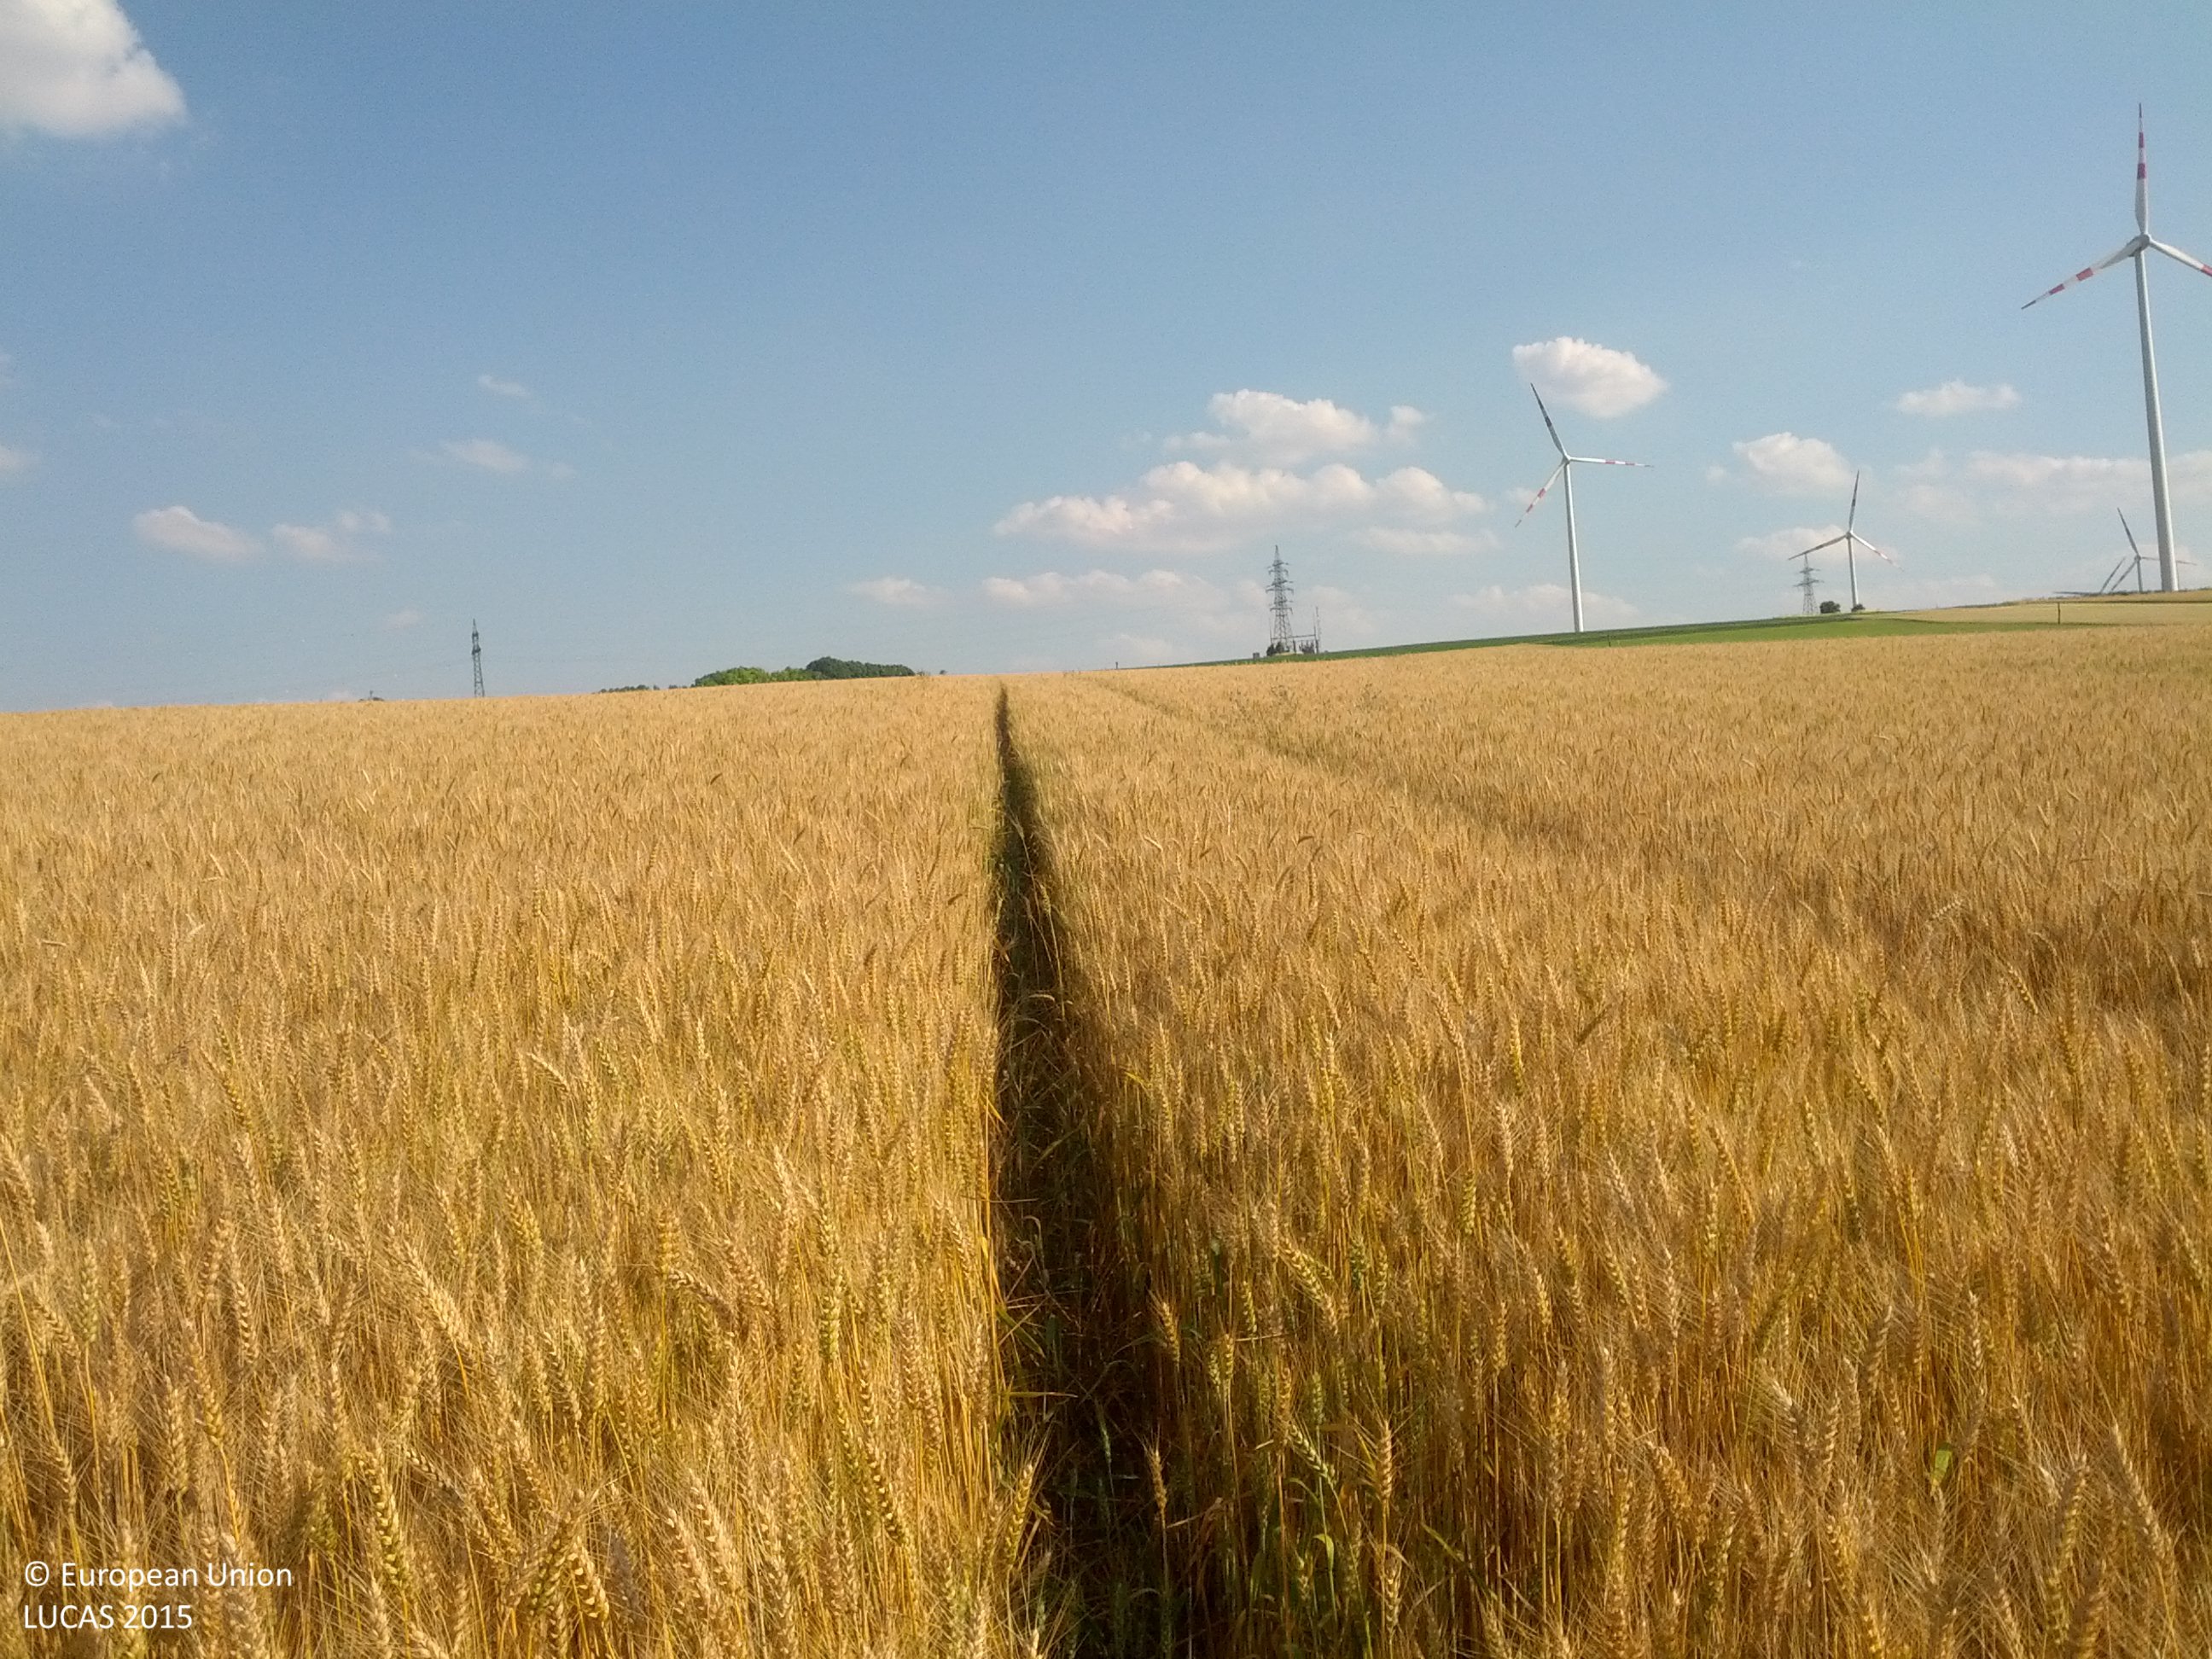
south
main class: Cropland
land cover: Common wheat
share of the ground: > 75 %
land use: Agriculture (excluding fallow land and kitchen gardens)
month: July
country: AT
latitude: 48.5946
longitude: 16.7460
